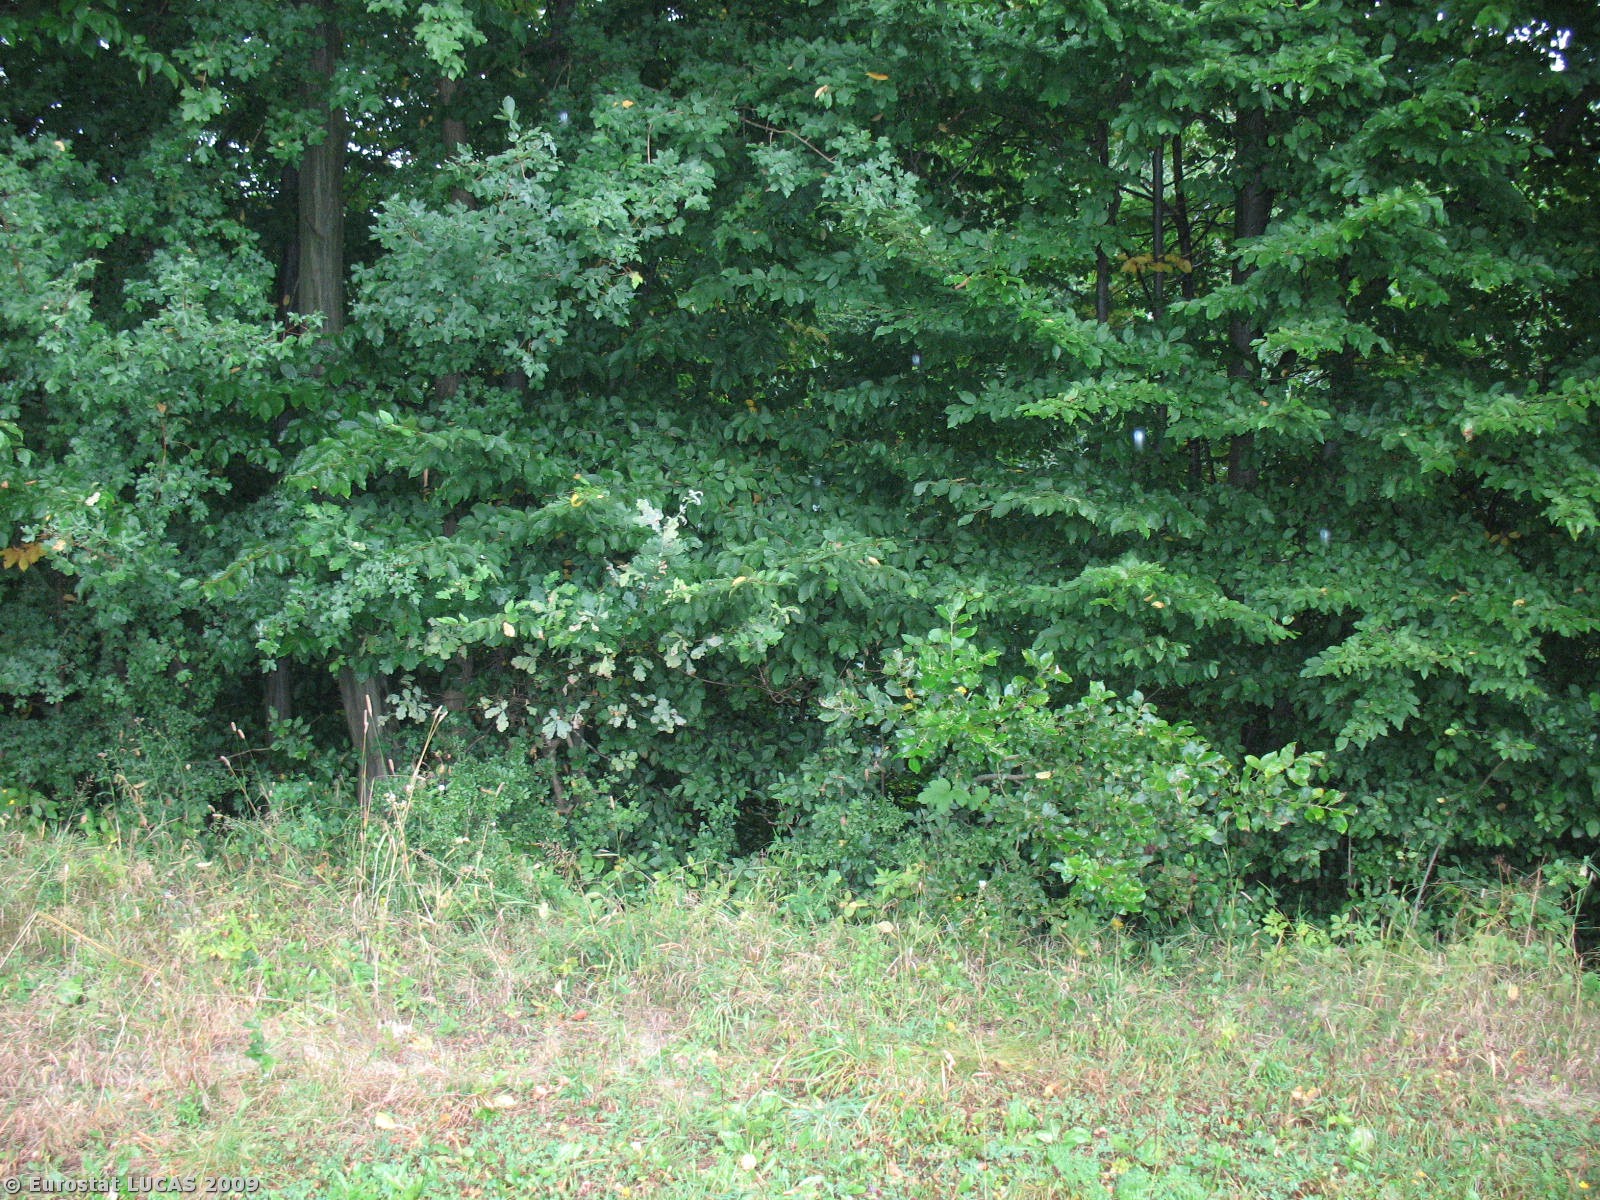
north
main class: Grassland
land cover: Spontaneously vegetated surfaces
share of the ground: > 75 %
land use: Fallow land
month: August
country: PL
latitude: 49.4076
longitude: 22.2854
